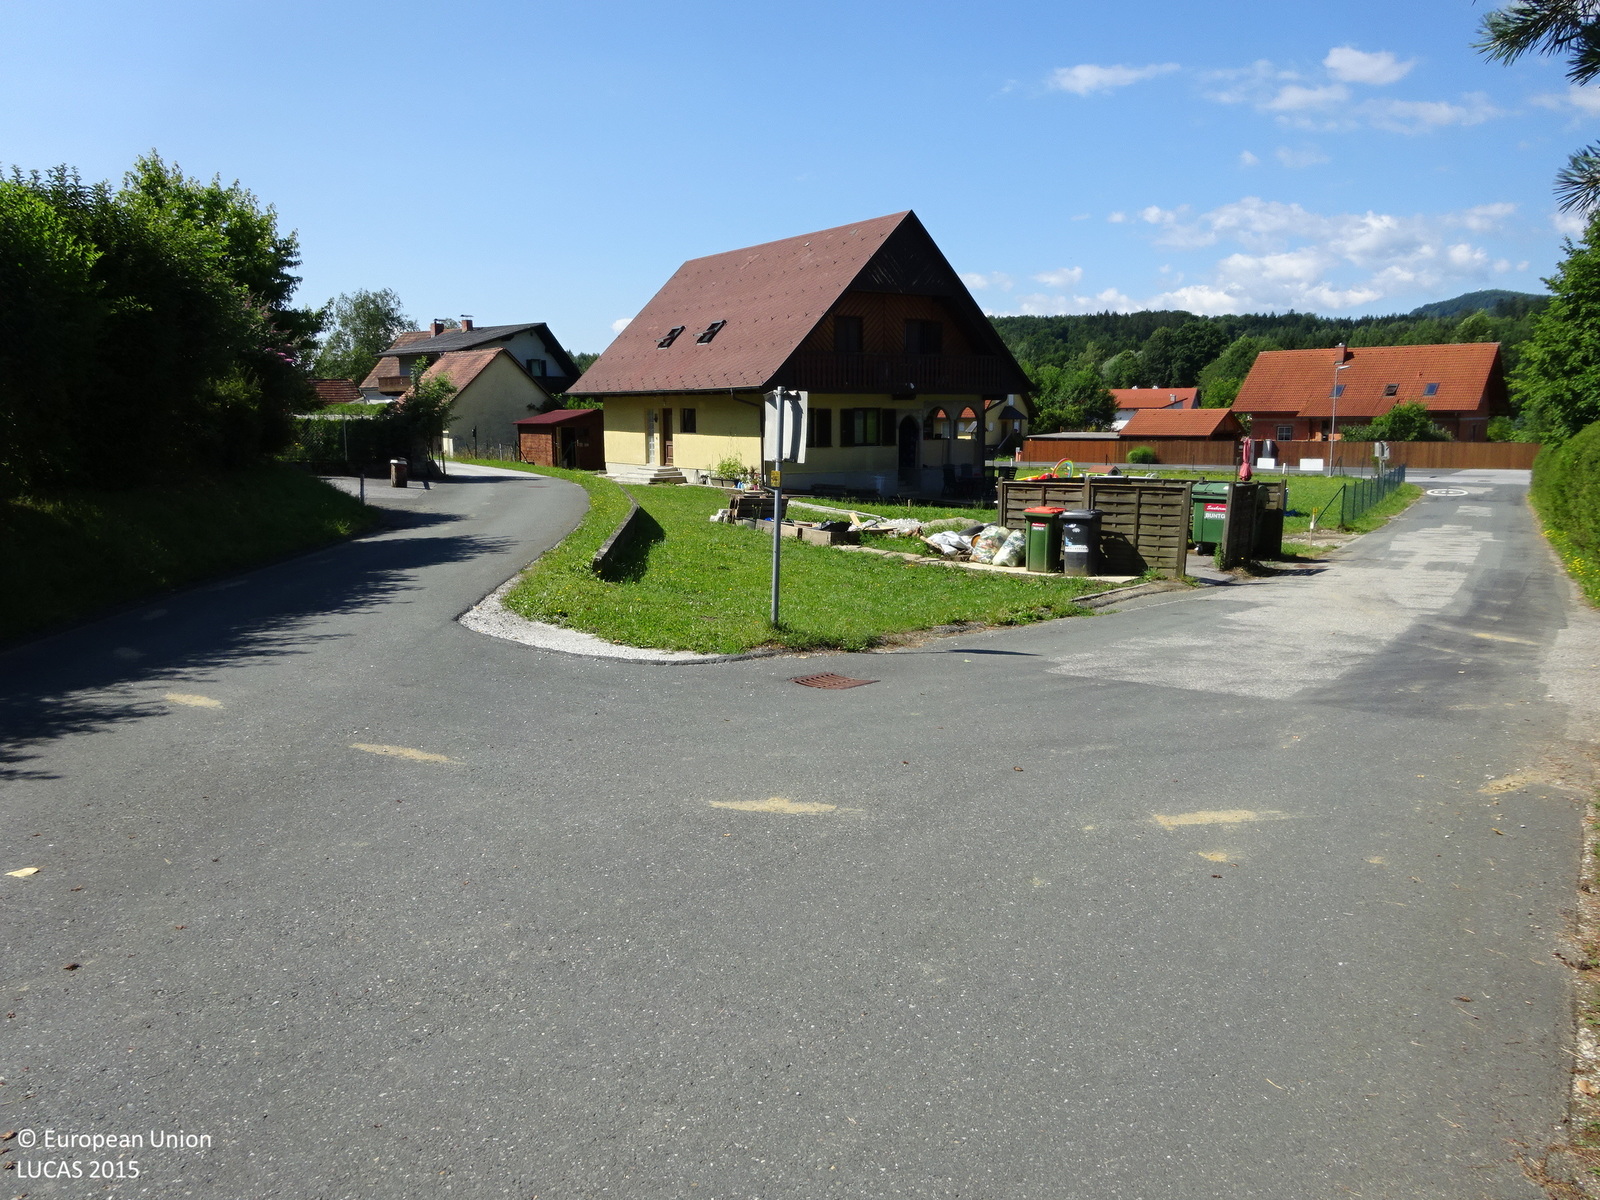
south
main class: Grassland
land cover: Grassland with sparse tree/shrub cover
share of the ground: > 75 %
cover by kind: herbaceous plants 90 %, coniferous forest trees 5 %, shrubs 5 %
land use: Residential
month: July
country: AT
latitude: 46.9074
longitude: 15.2637
